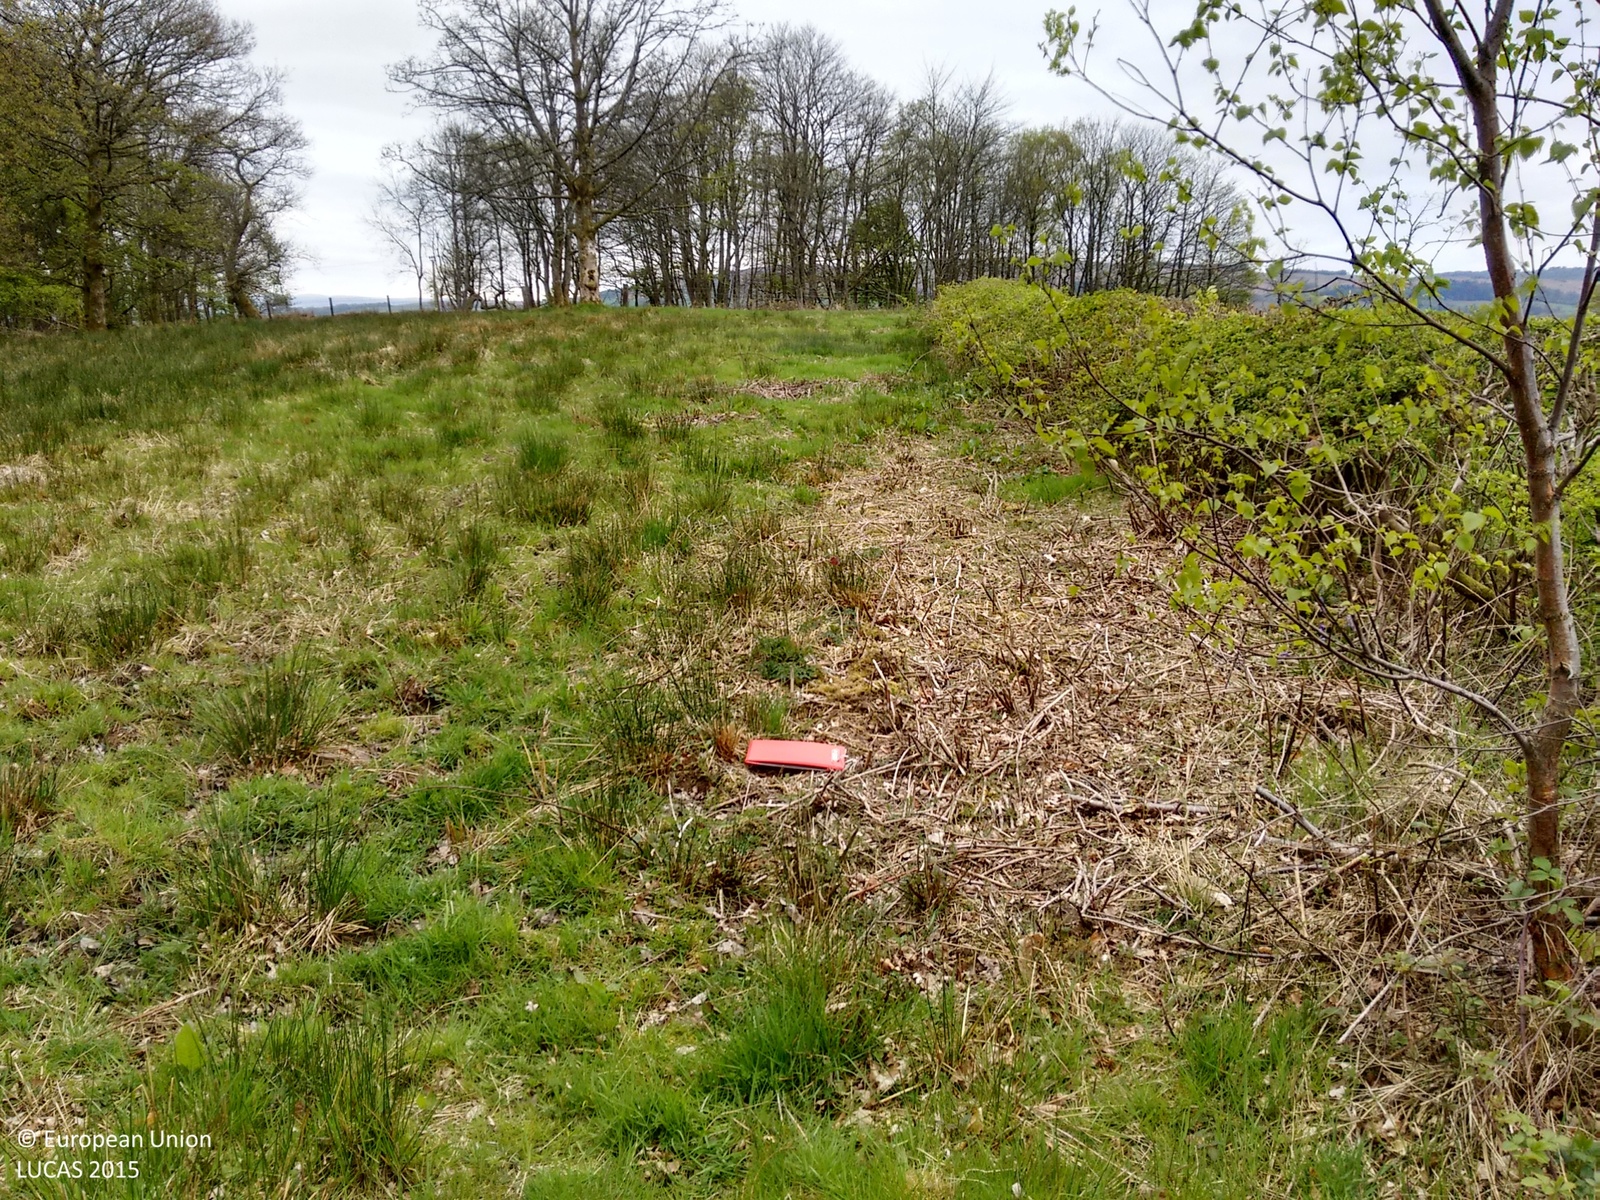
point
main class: Grassland
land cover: Grassland without tree/shrub cover
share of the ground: > 75 %
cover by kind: herbaceous plants 90 %, shrubs 5 %, unconsolidated bare surface 5 %
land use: Semi-natural and natural areas not in use
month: May
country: GB
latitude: 56.0111
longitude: -4.5507
